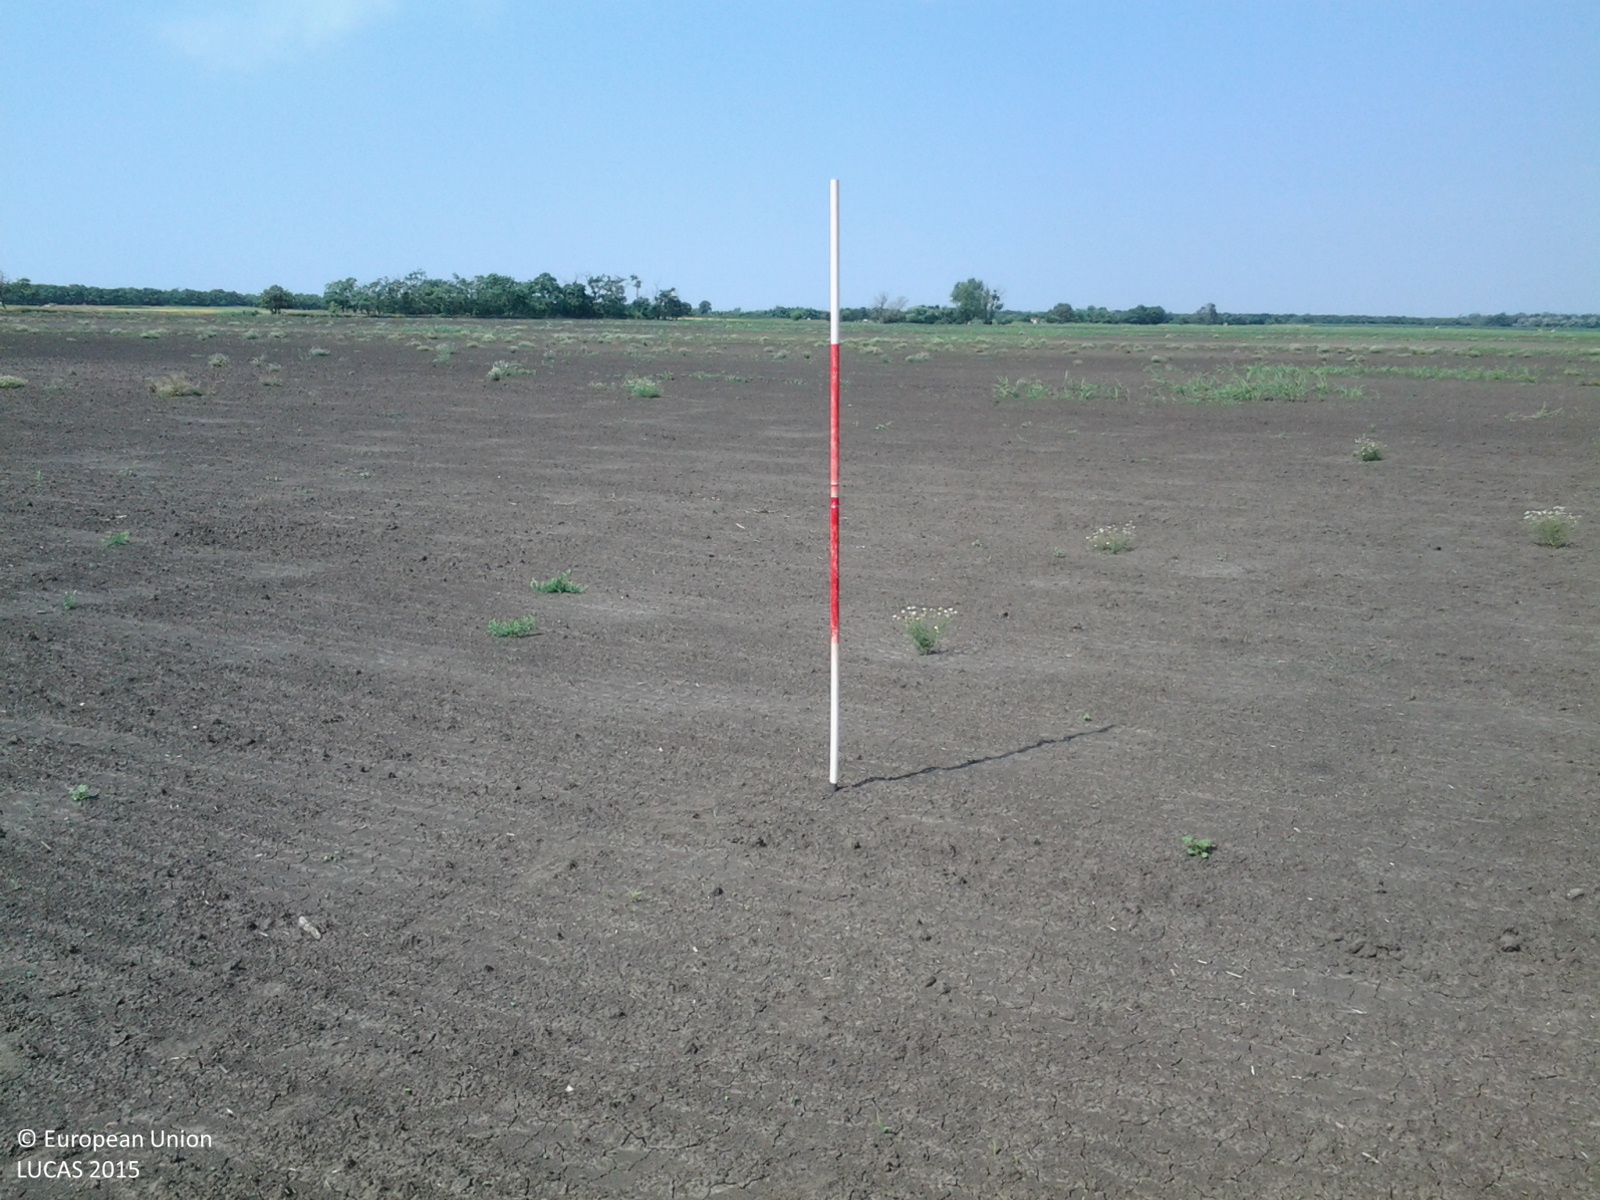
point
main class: Cropland
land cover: Maize
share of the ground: < 10 %
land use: Agriculture (excluding fallow land and kitchen gardens)
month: July
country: HU
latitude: 46.9812
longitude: 20.4535
